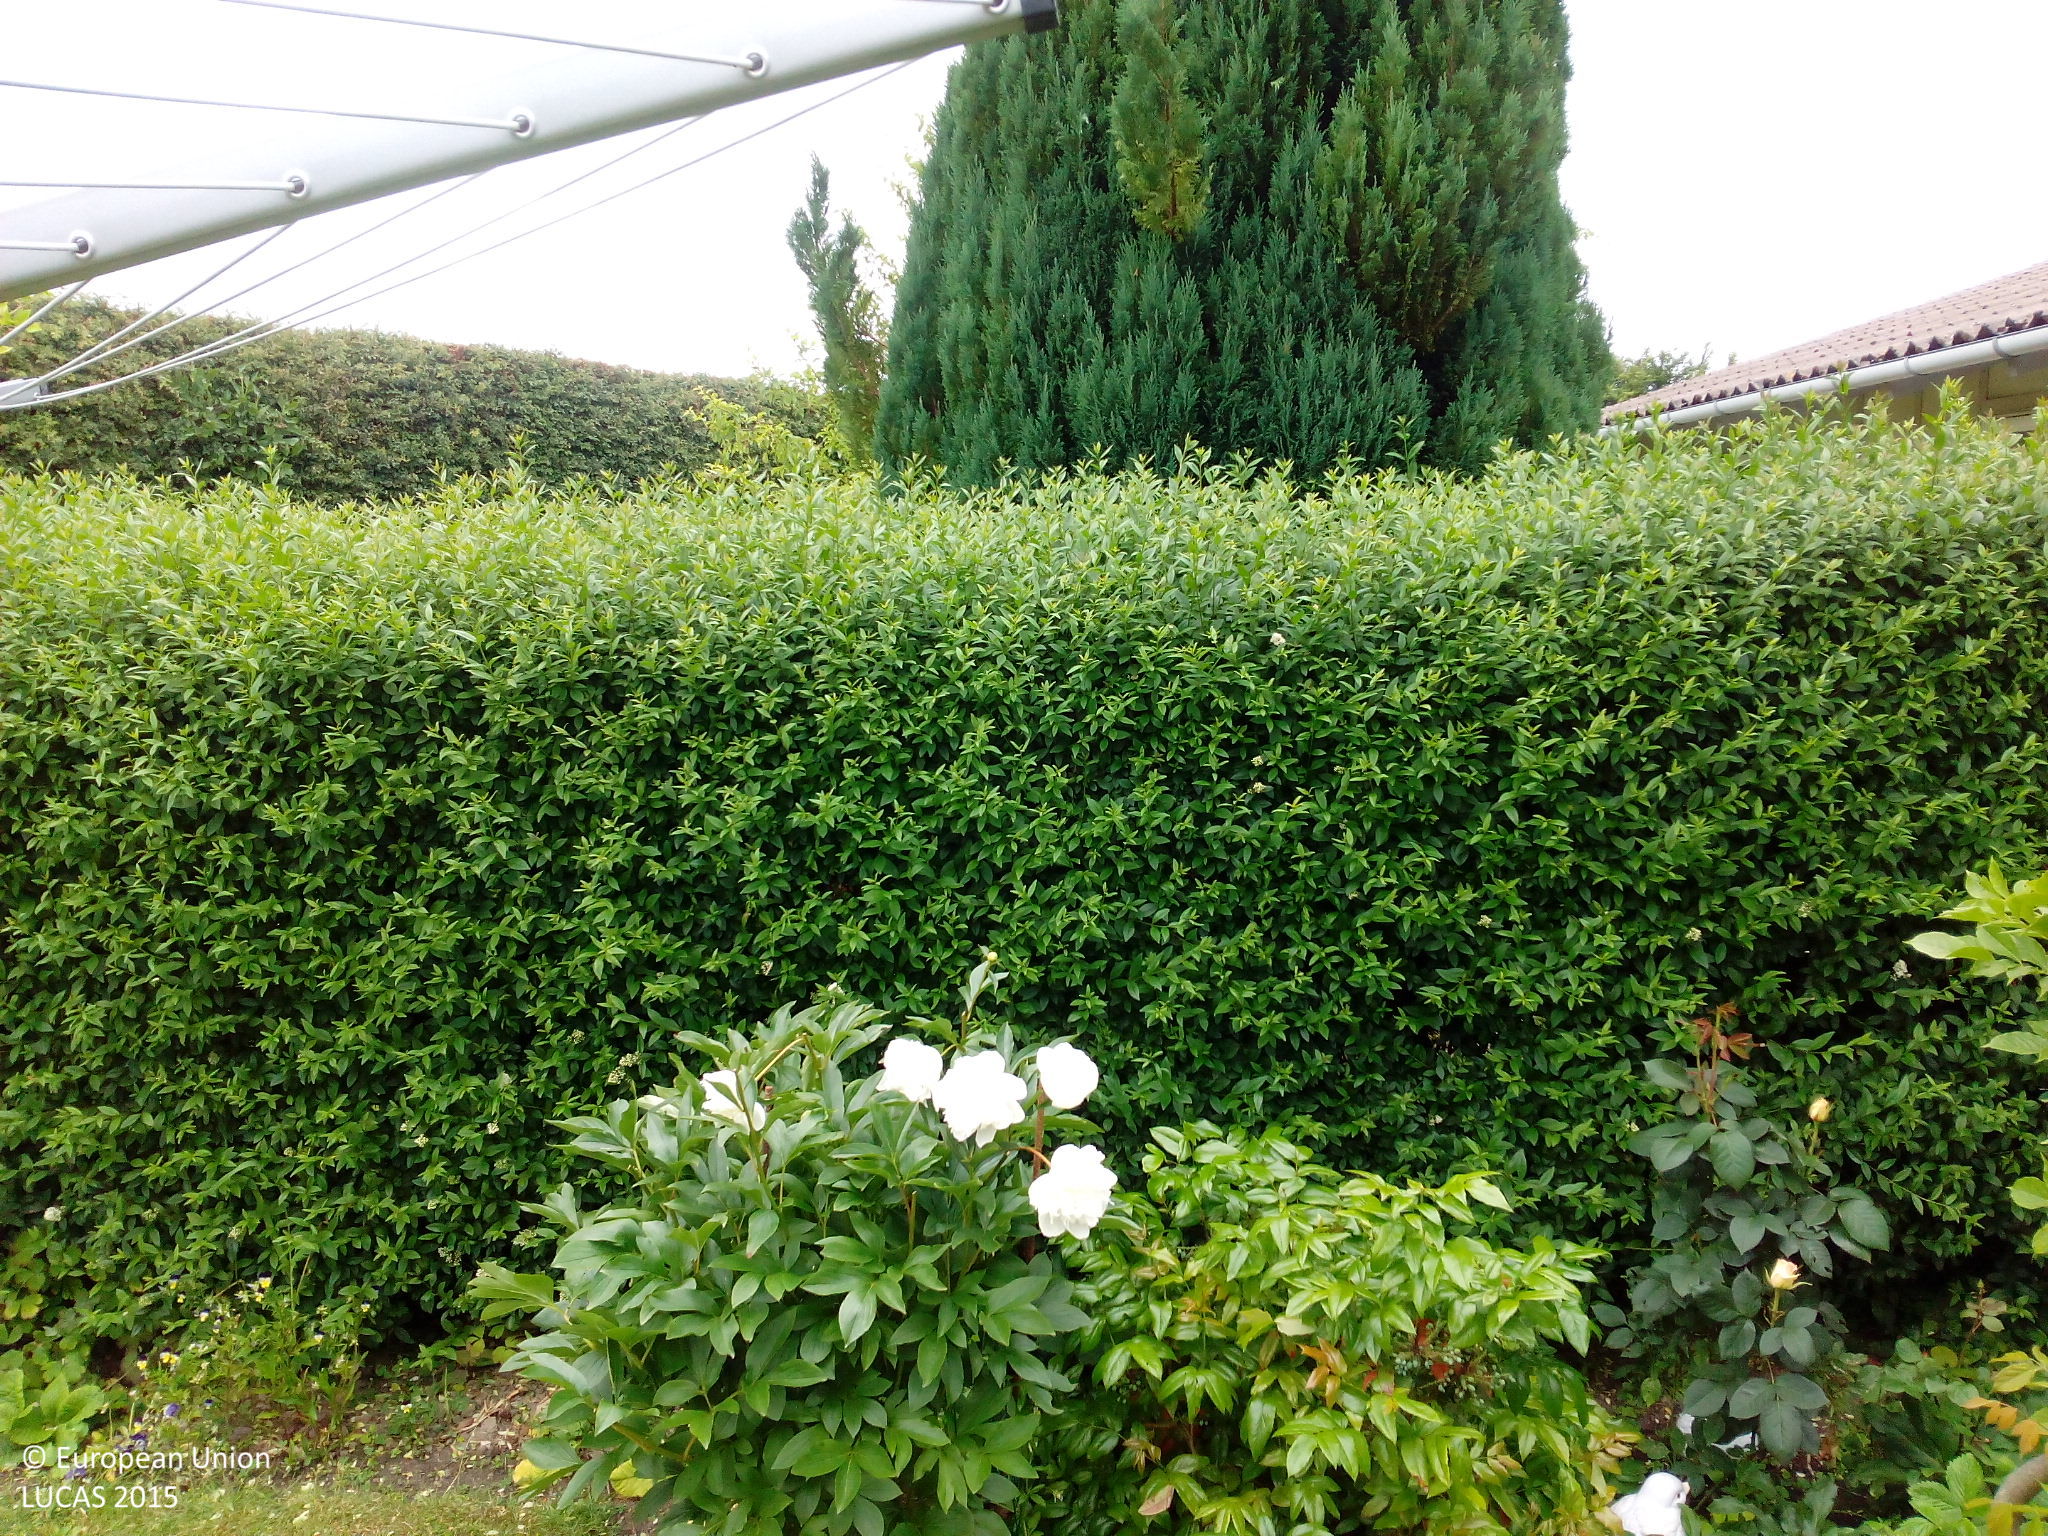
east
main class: Grassland
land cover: Grassland without tree/shrub cover
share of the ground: > 75 %
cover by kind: herbaceous plants 100 %
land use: Residential
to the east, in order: Grassland without tree/shrub cover; Artificial constructions in urban areas
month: July
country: DK
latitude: 55.2547
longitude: 12.0281
